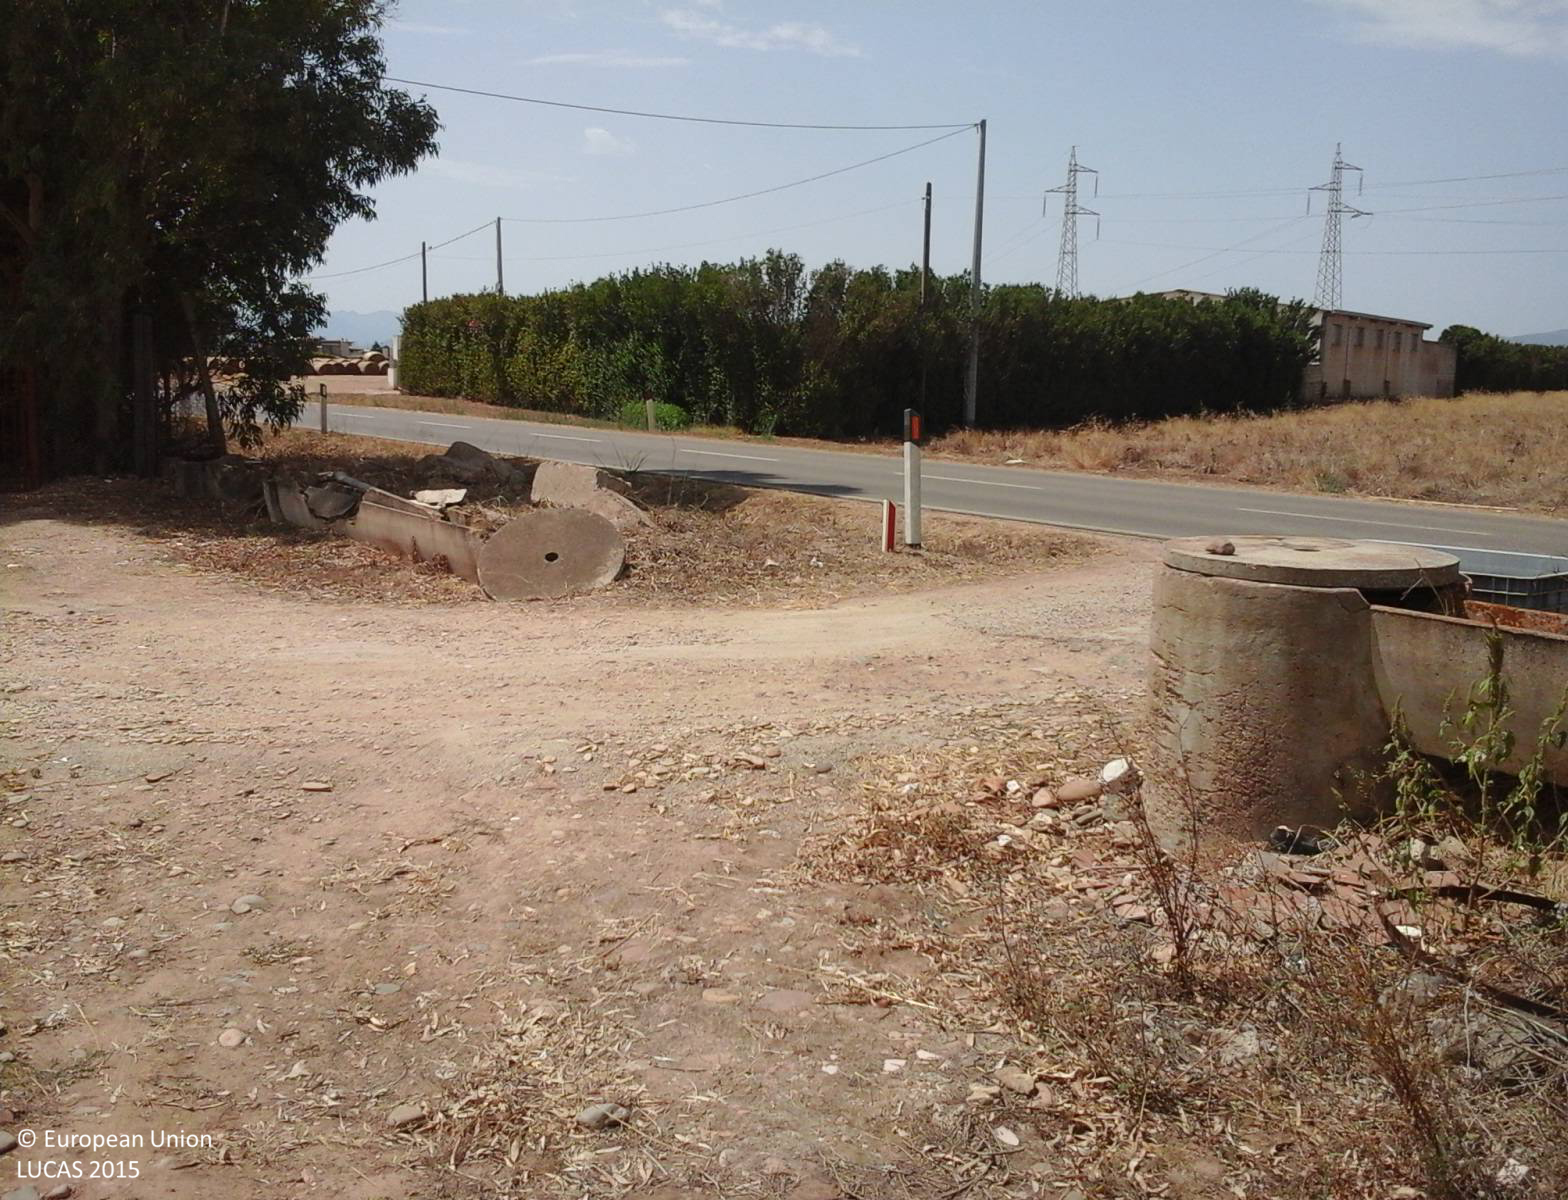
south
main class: Cropland
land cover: Olive groves
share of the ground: > 75 %
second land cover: Grassland without tree/shrub cover
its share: > 75 %
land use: Agriculture (excluding fallow land and kitchen gardens)
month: July
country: IT
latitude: 39.5005
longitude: 8.9018
